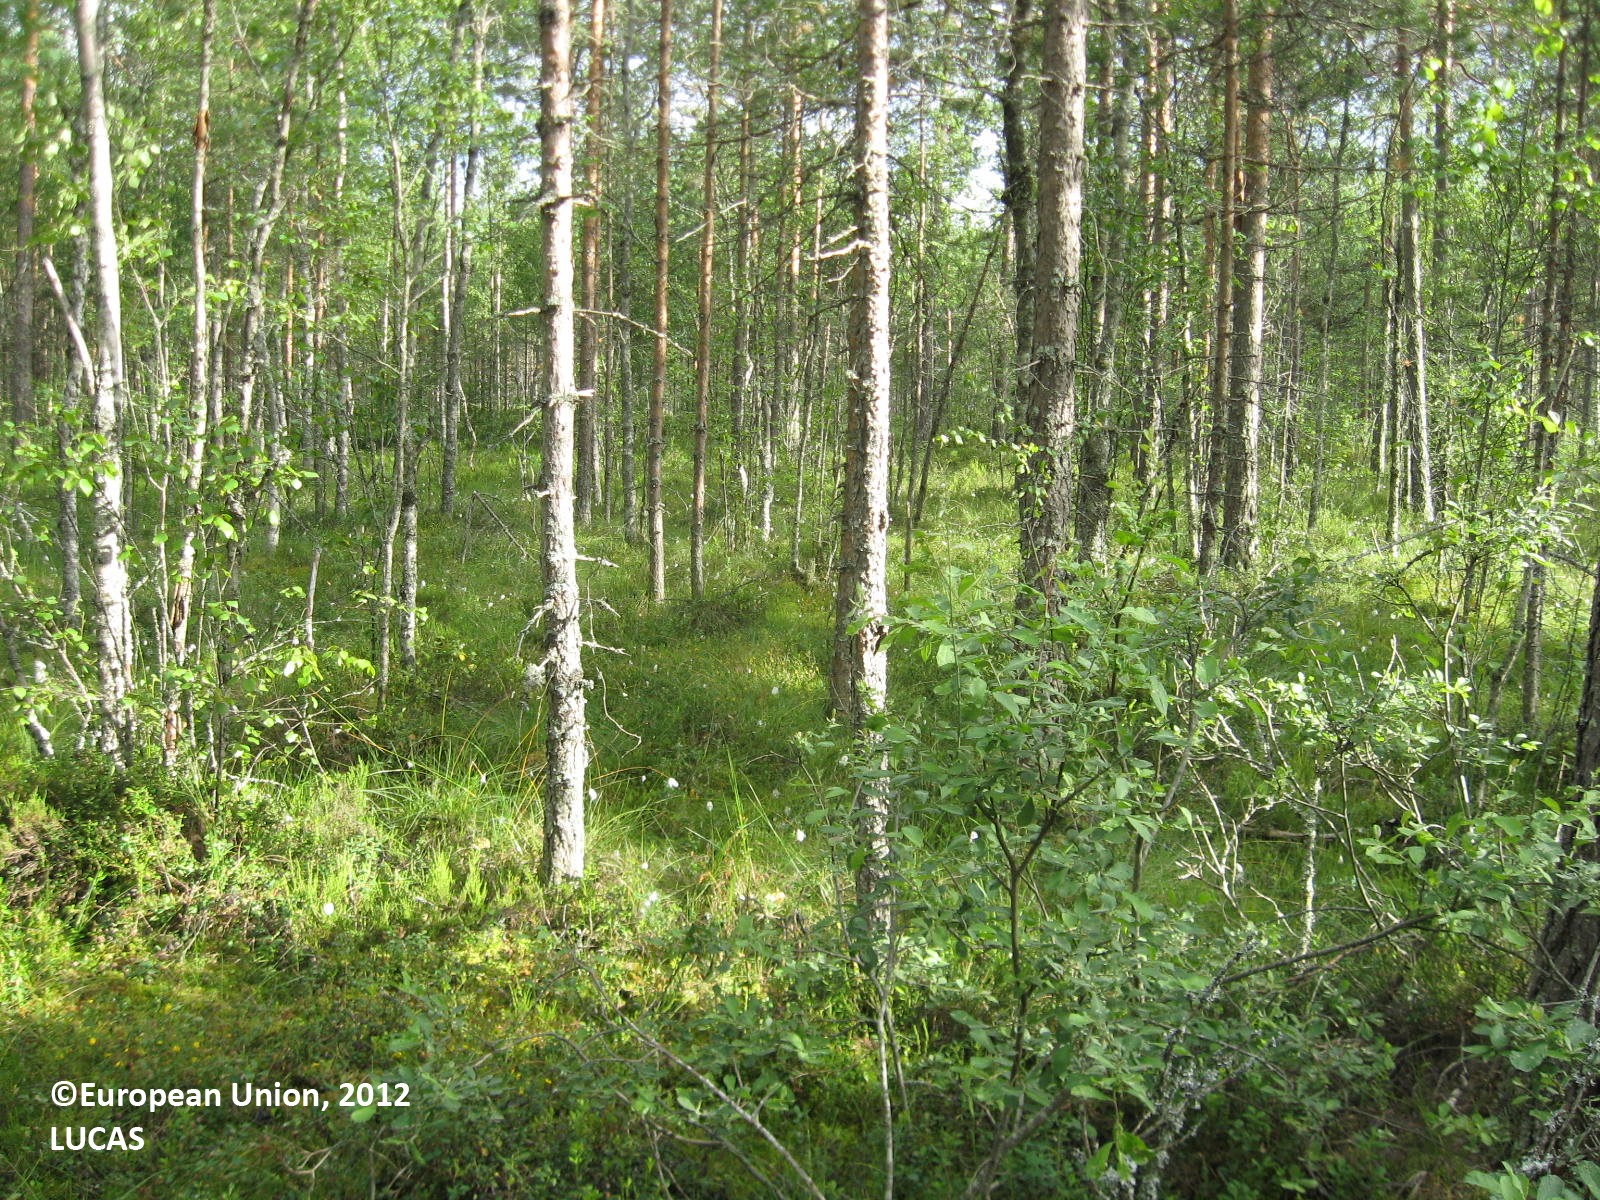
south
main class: Woodland
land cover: Pine dominated mixed woodland
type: boreal forest
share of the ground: > 75 %
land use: Forestry
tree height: > 5 m
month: July
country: FI
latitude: 62.1495
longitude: 22.4338
